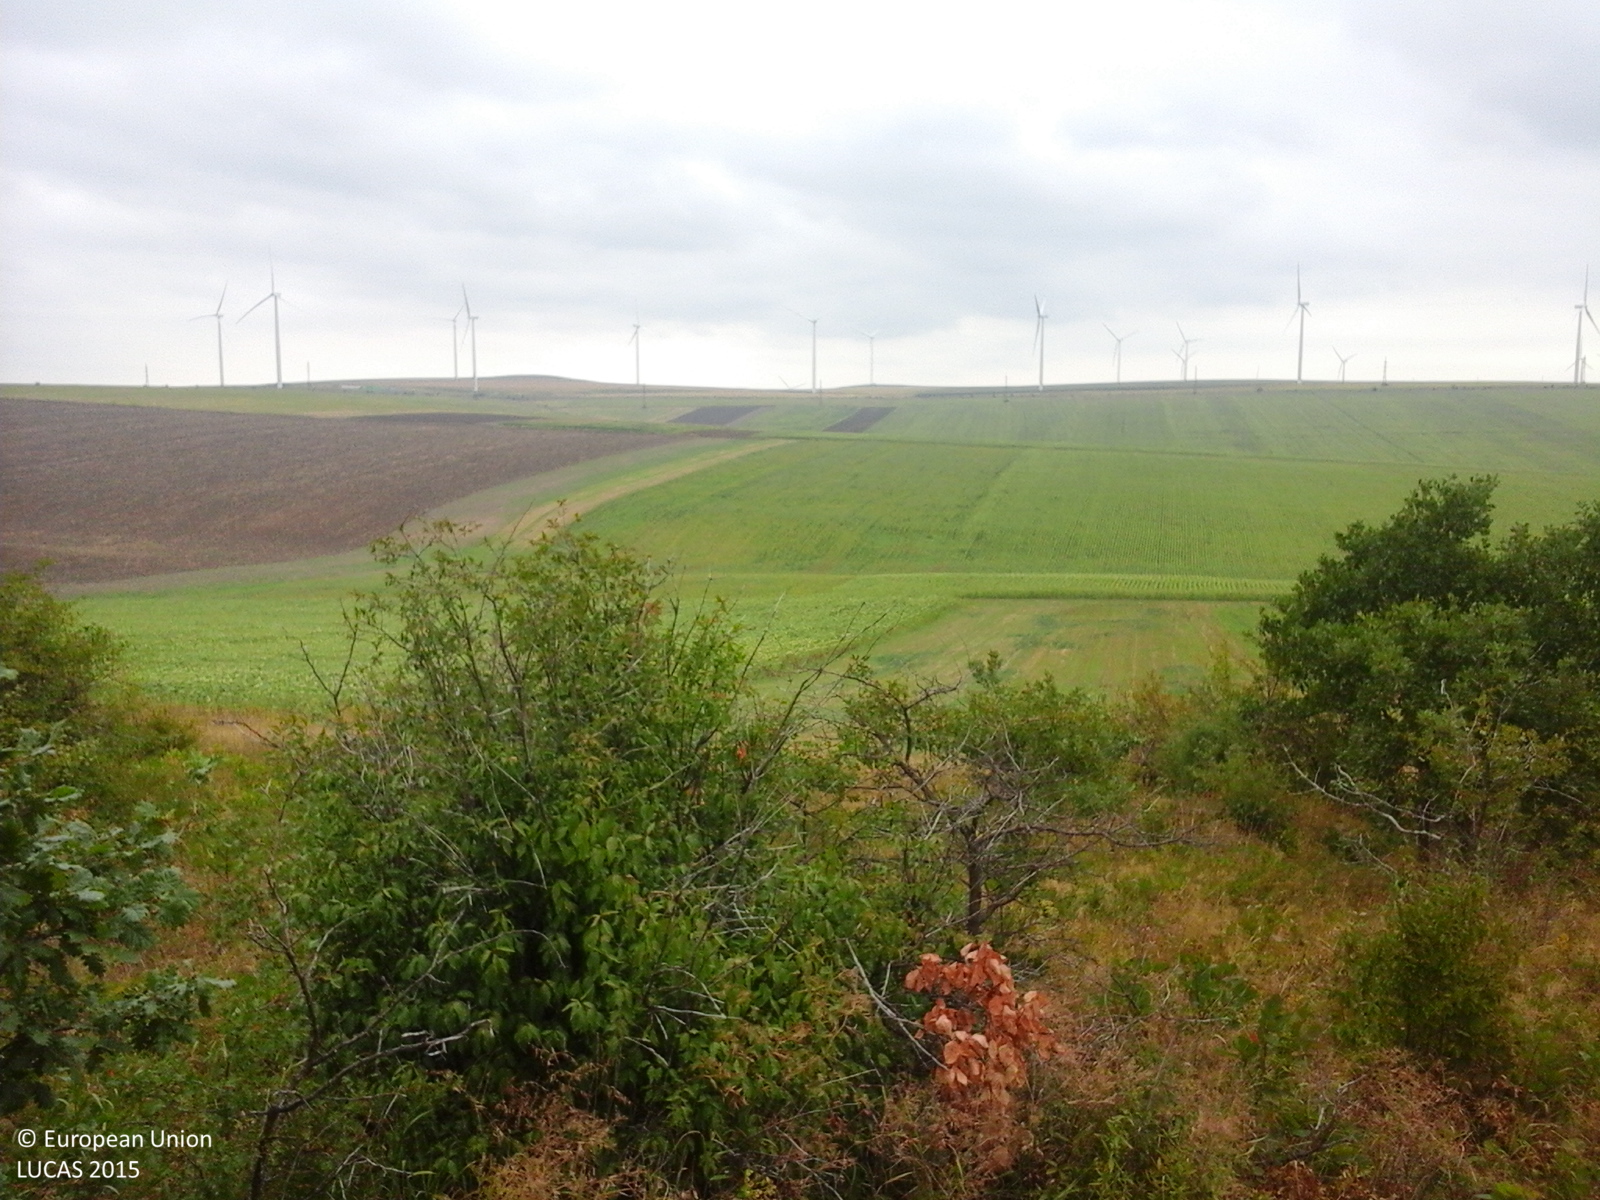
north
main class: Shrubland
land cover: Shrubland with sparse tree cover
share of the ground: > 75 %
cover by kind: shrubs 75 %, herbaceous plants 20 %, broadleaved forest trees 5 %
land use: Agriculture (excluding fallow land and kitchen gardens)
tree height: > 5 m
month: August
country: RO
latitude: 44.8935
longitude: 28.6581
